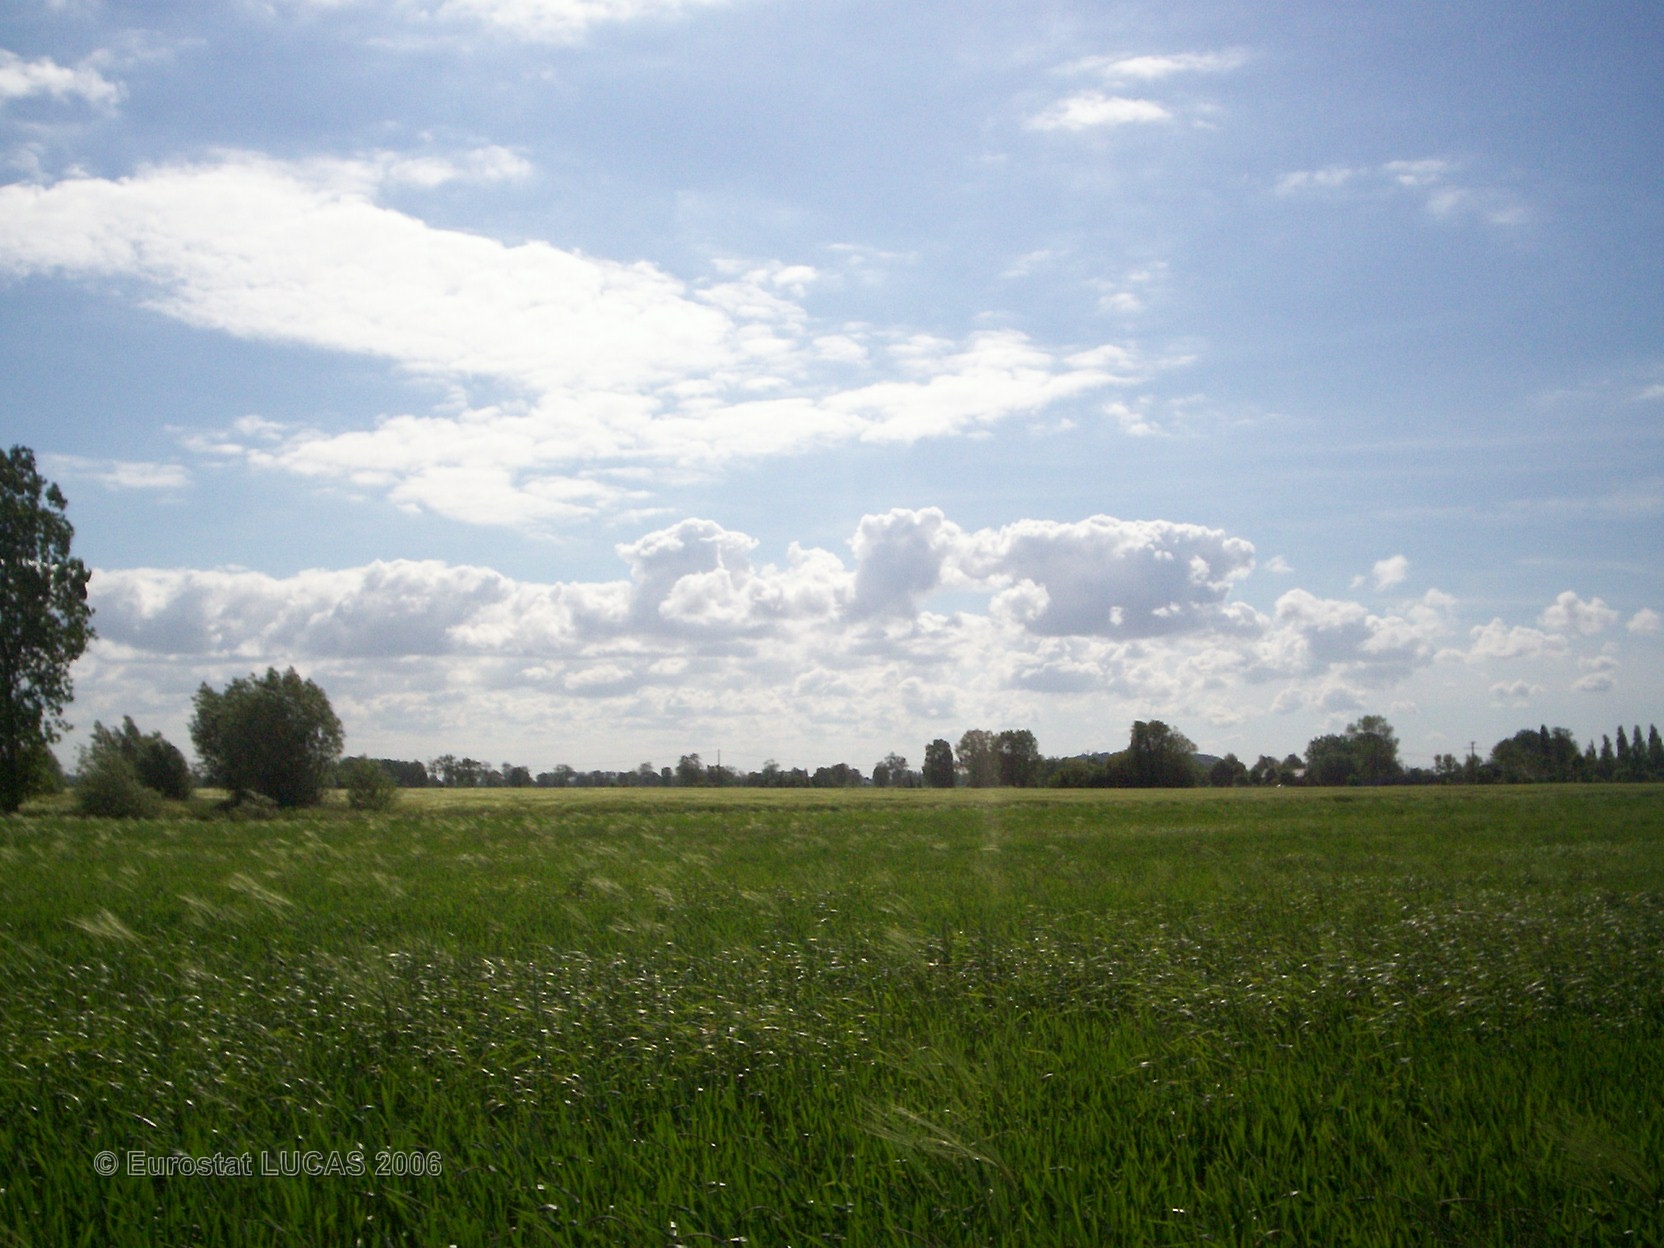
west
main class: Cropland
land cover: Common wheat
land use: Agriculture (excluding fallow land and kitchen gardens)
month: May
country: FR
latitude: 48.5776
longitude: -1.7207
